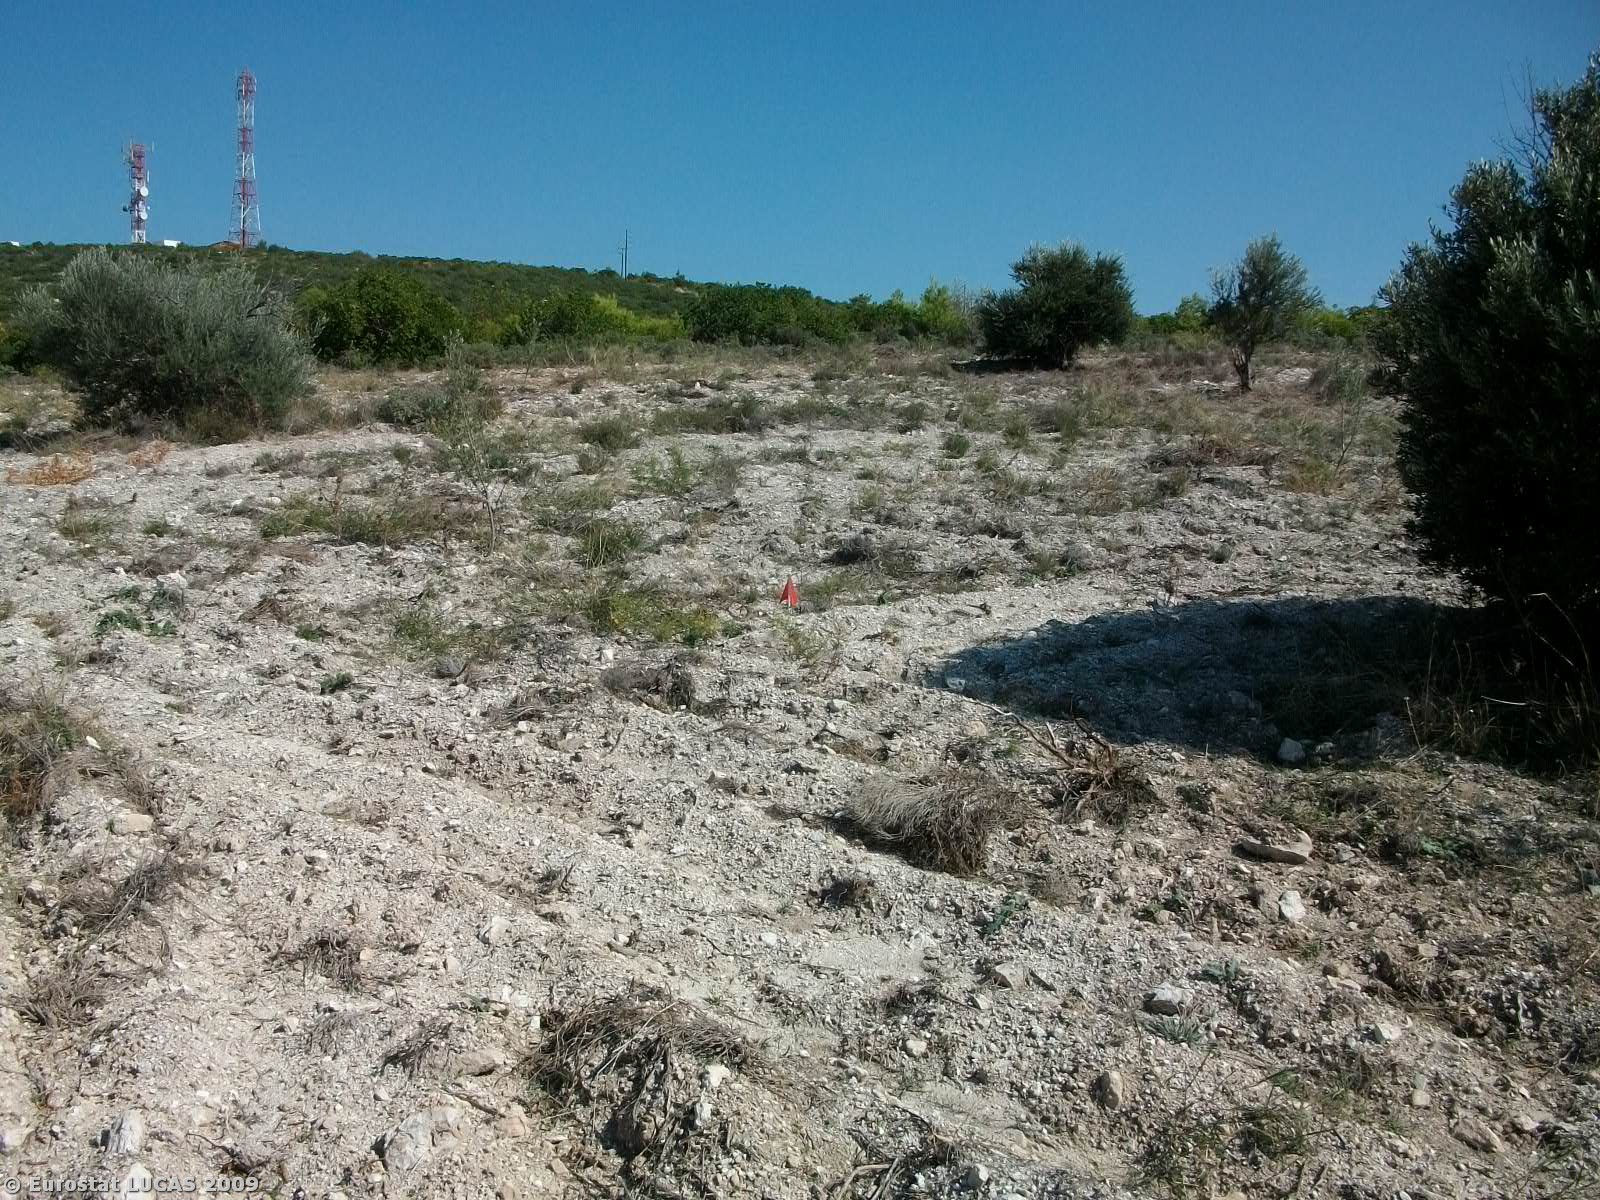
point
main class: Cropland
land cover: Olive groves
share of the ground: < 10 %
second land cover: Grassland with sparse tree/shrub cover
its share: 50 - 75 %
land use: Agriculture (excluding fallow land and kitchen gardens)
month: September
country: GR
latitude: 38.2742
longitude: 23.8285
